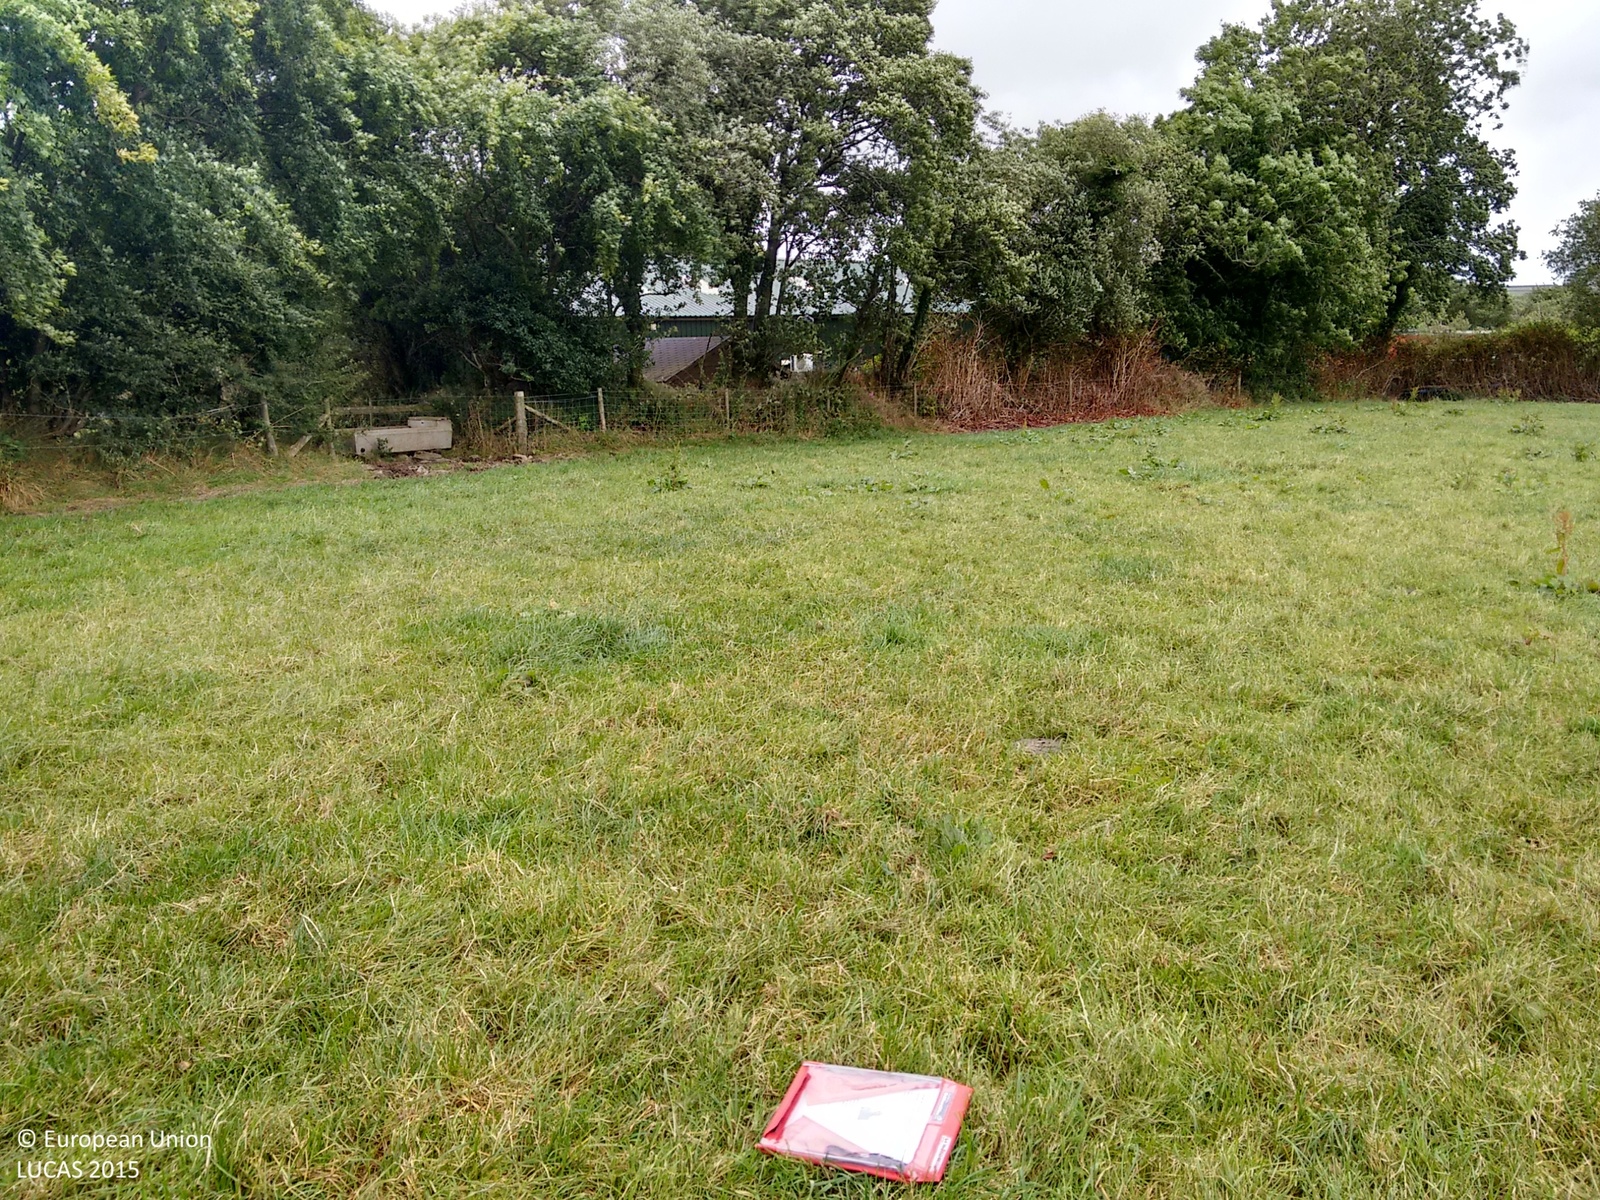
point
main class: Grassland
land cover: Grassland without tree/shrub cover
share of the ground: > 75 %
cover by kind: herbaceous plants 100 %
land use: Agriculture (excluding fallow land and kitchen gardens)
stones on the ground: < 10 %
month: August
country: GB
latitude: 51.9388
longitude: -4.4912
